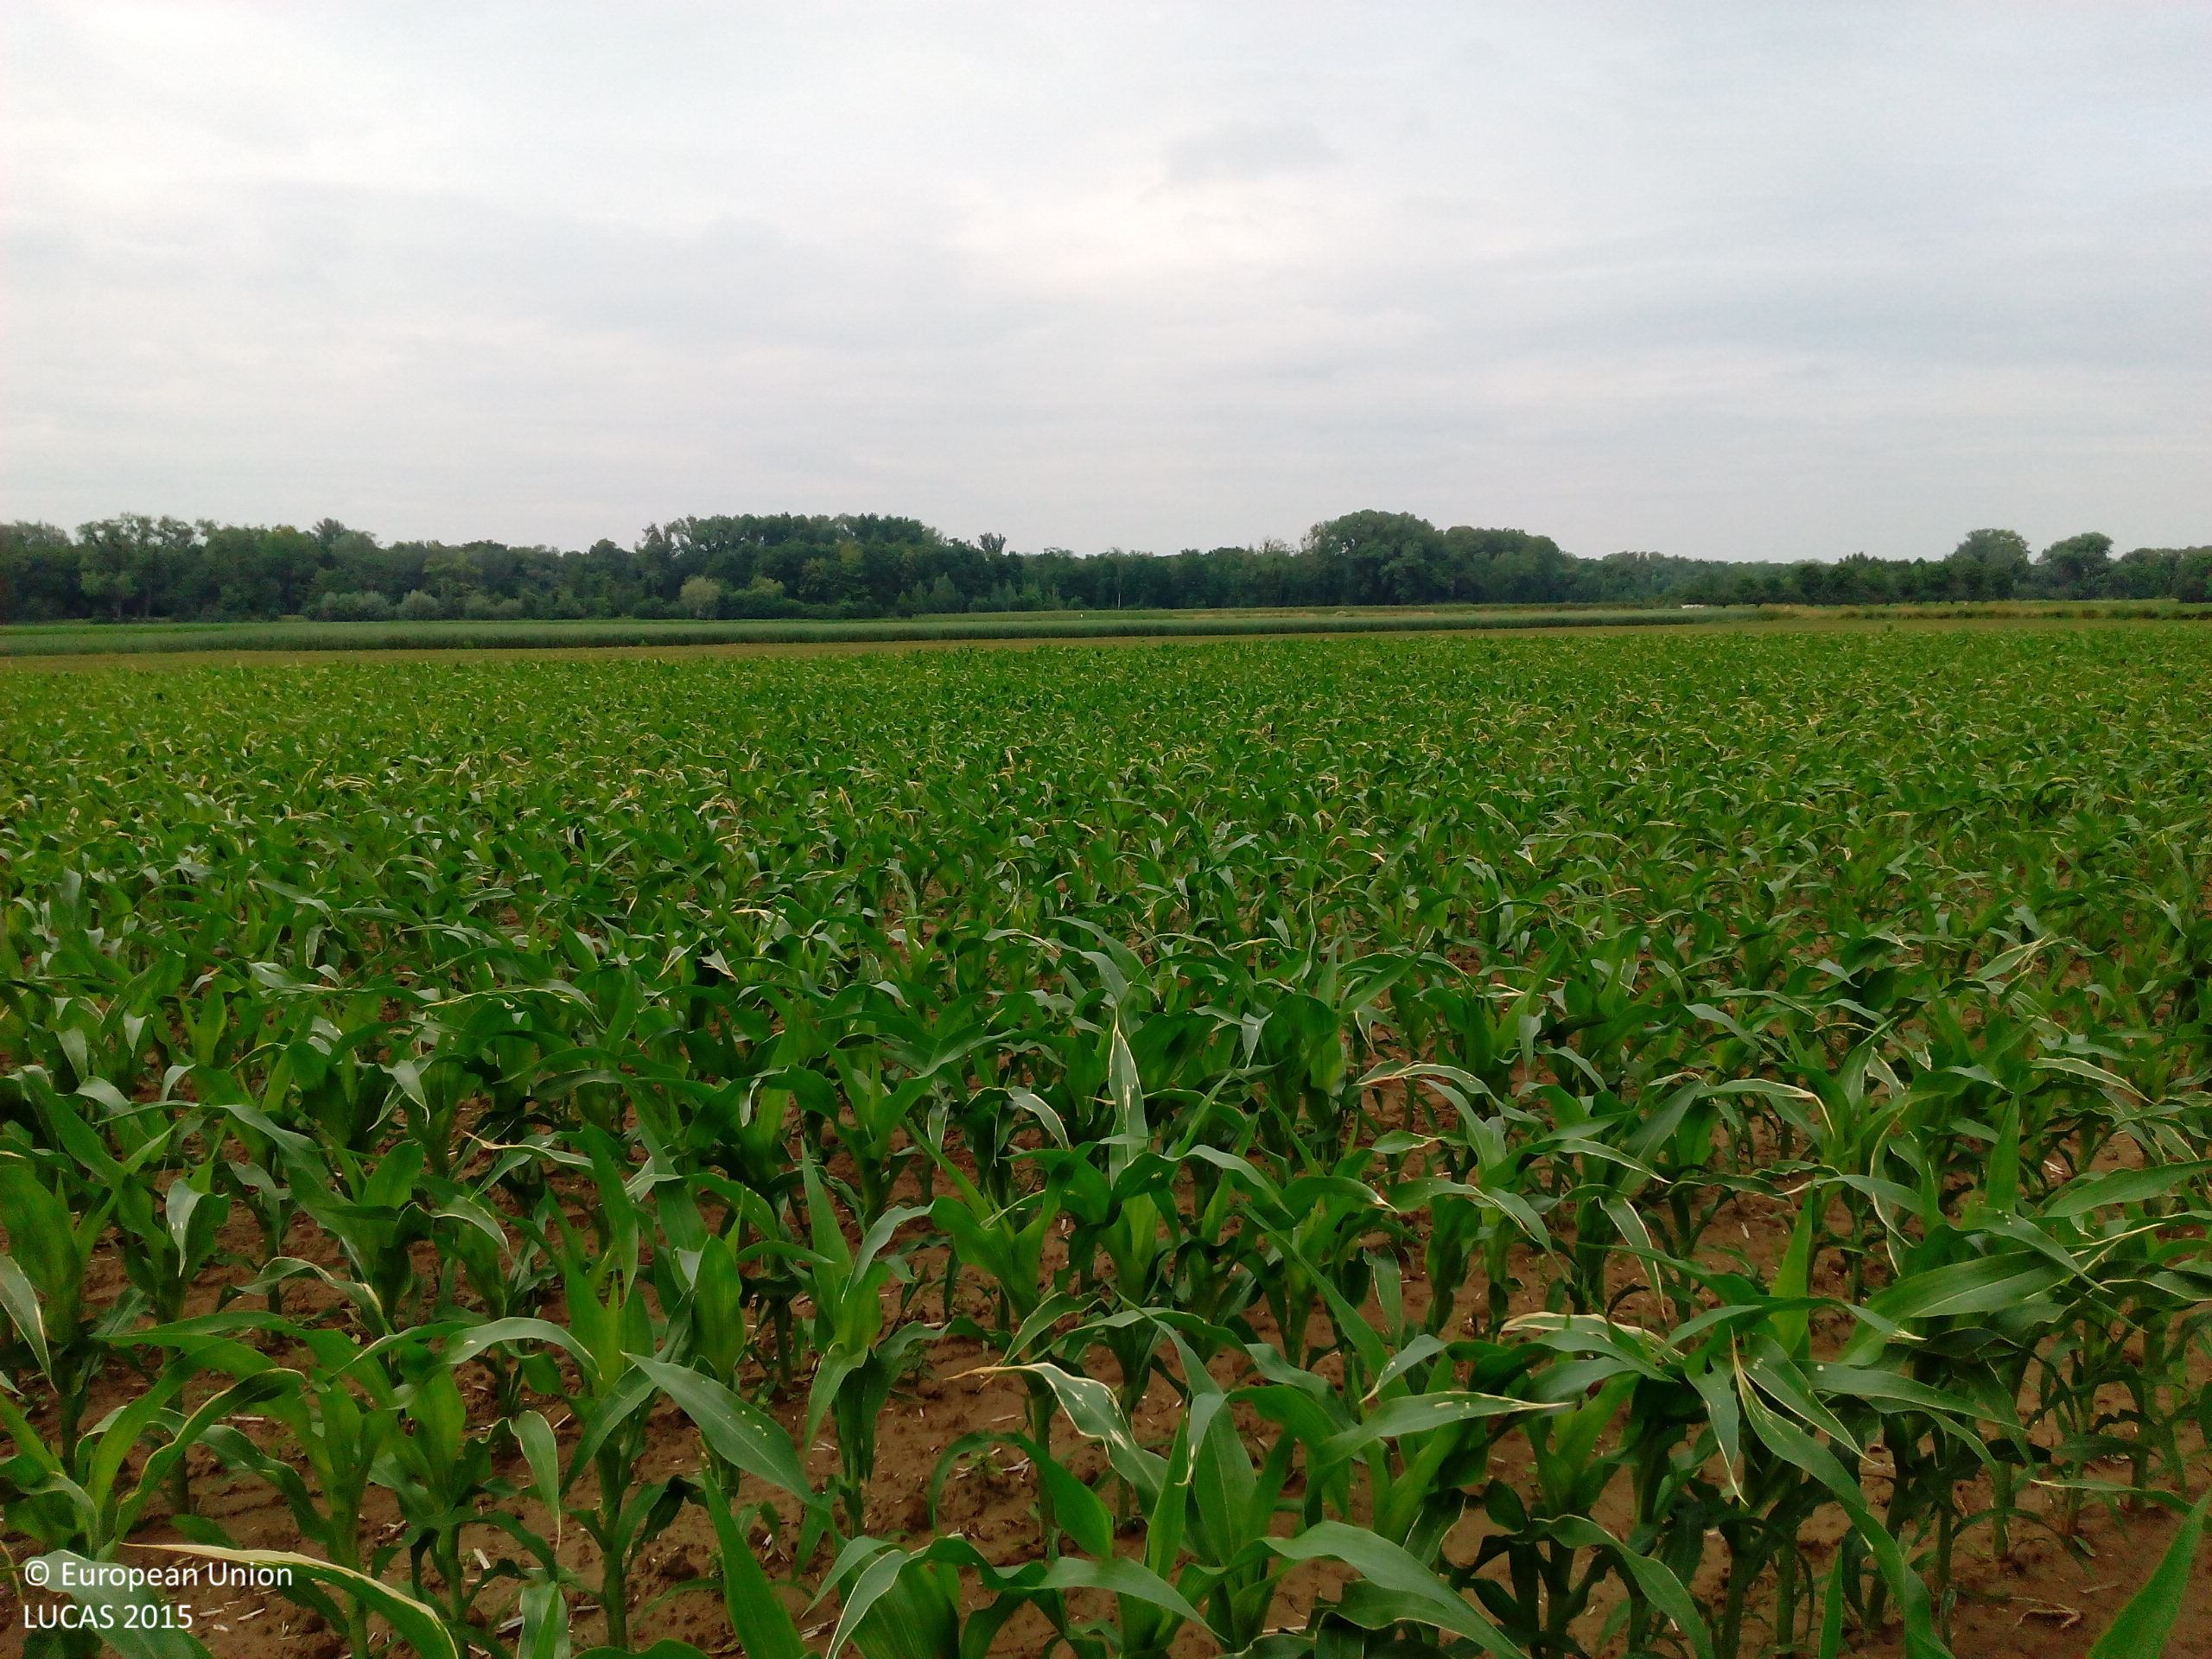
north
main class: Cropland
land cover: Maize
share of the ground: > 75 %
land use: Agriculture (excluding fallow land and kitchen gardens)
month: June
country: DE
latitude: 48.1619
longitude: 7.6214
